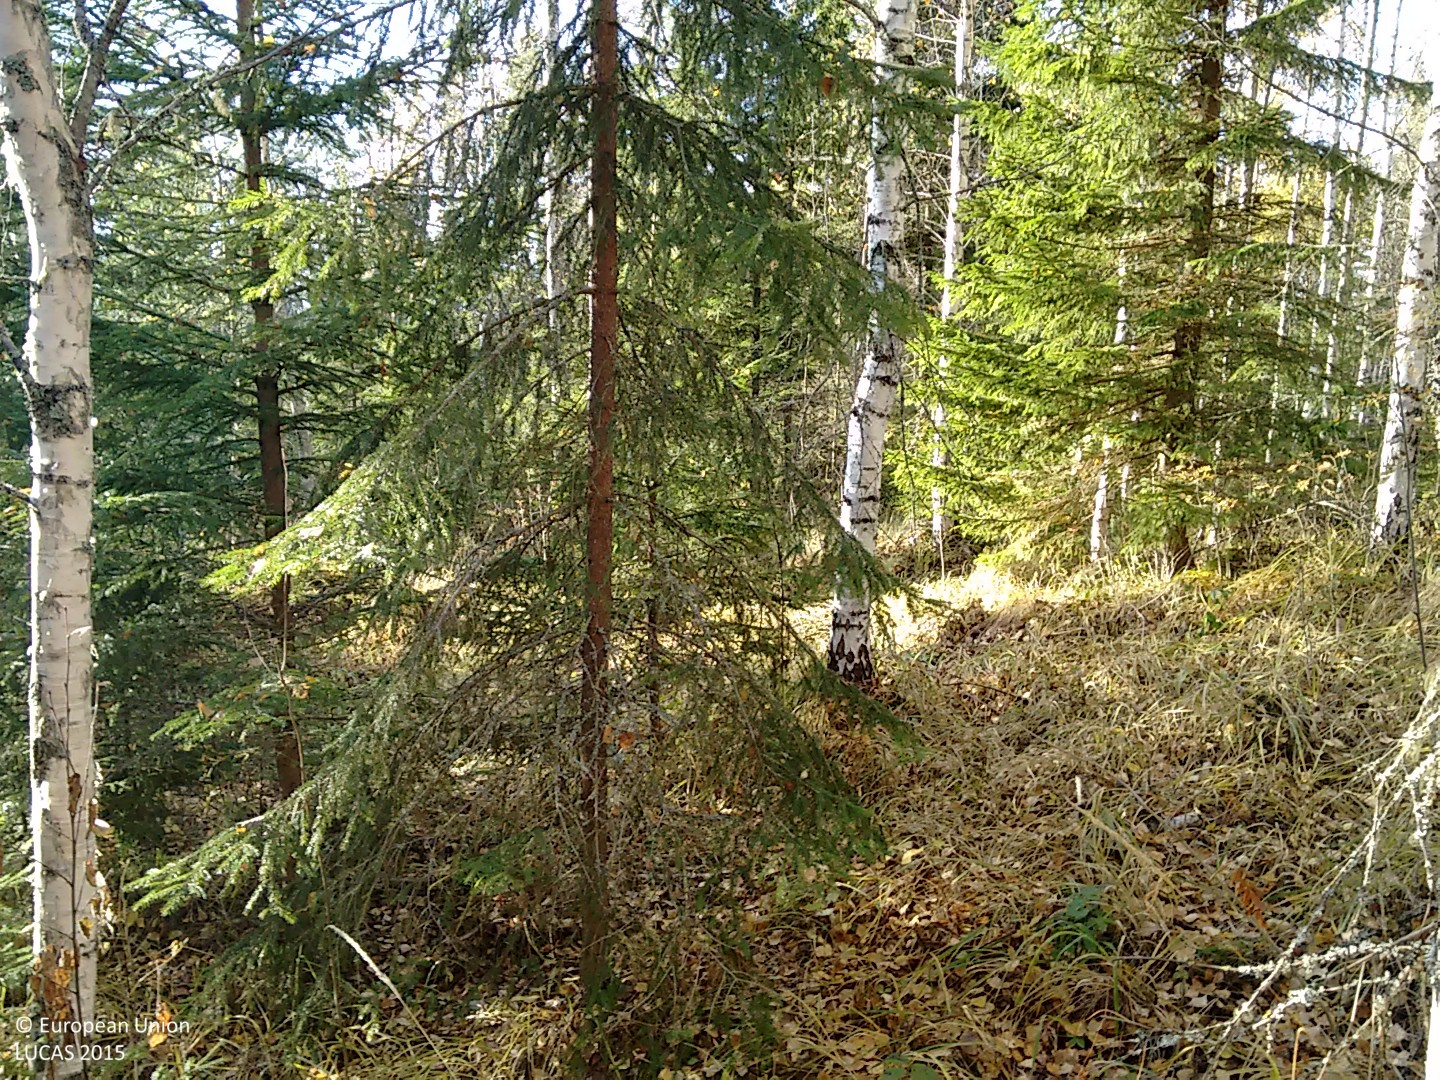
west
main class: Woodland
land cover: Spruce dominated mixed woodland
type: boreal forest
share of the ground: > 75 %
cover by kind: coniferous forest trees 45 %, broadleaved forest trees 40 %, shrubs 15 %
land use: Forestry
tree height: > 5 m
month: October
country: FI
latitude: 62.6495
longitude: 25.8640
